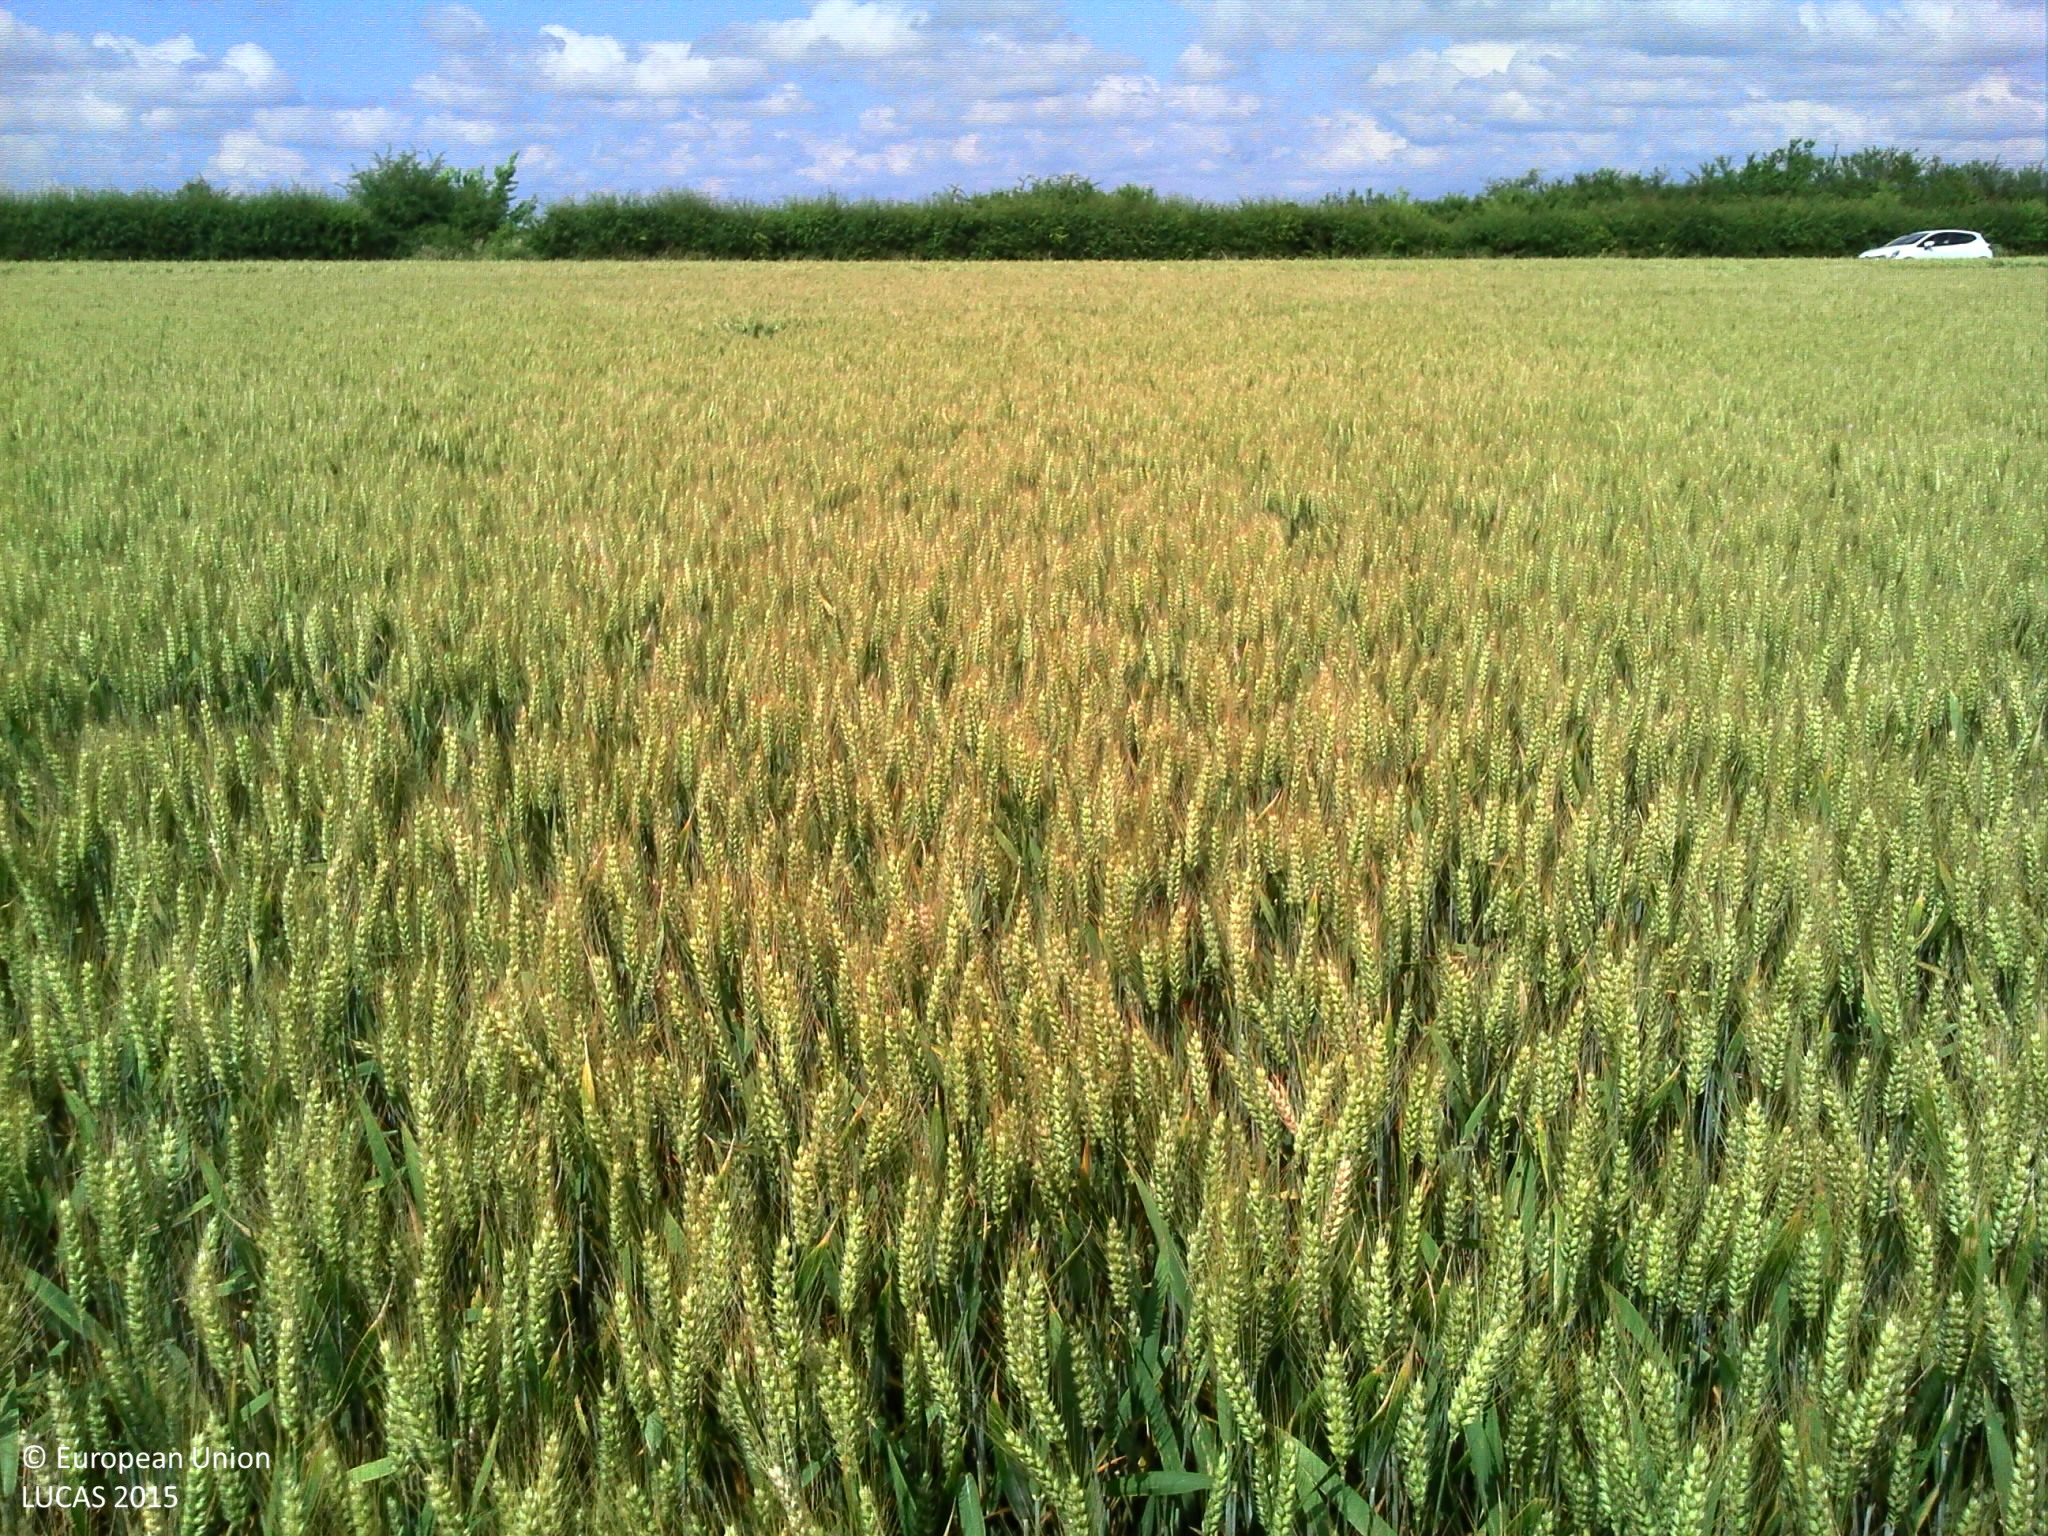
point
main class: Cropland
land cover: Common wheat
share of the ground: > 75 %
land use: Agriculture (excluding fallow land and kitchen gardens)
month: June
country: FR
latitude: 46.6681
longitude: 0.2685
